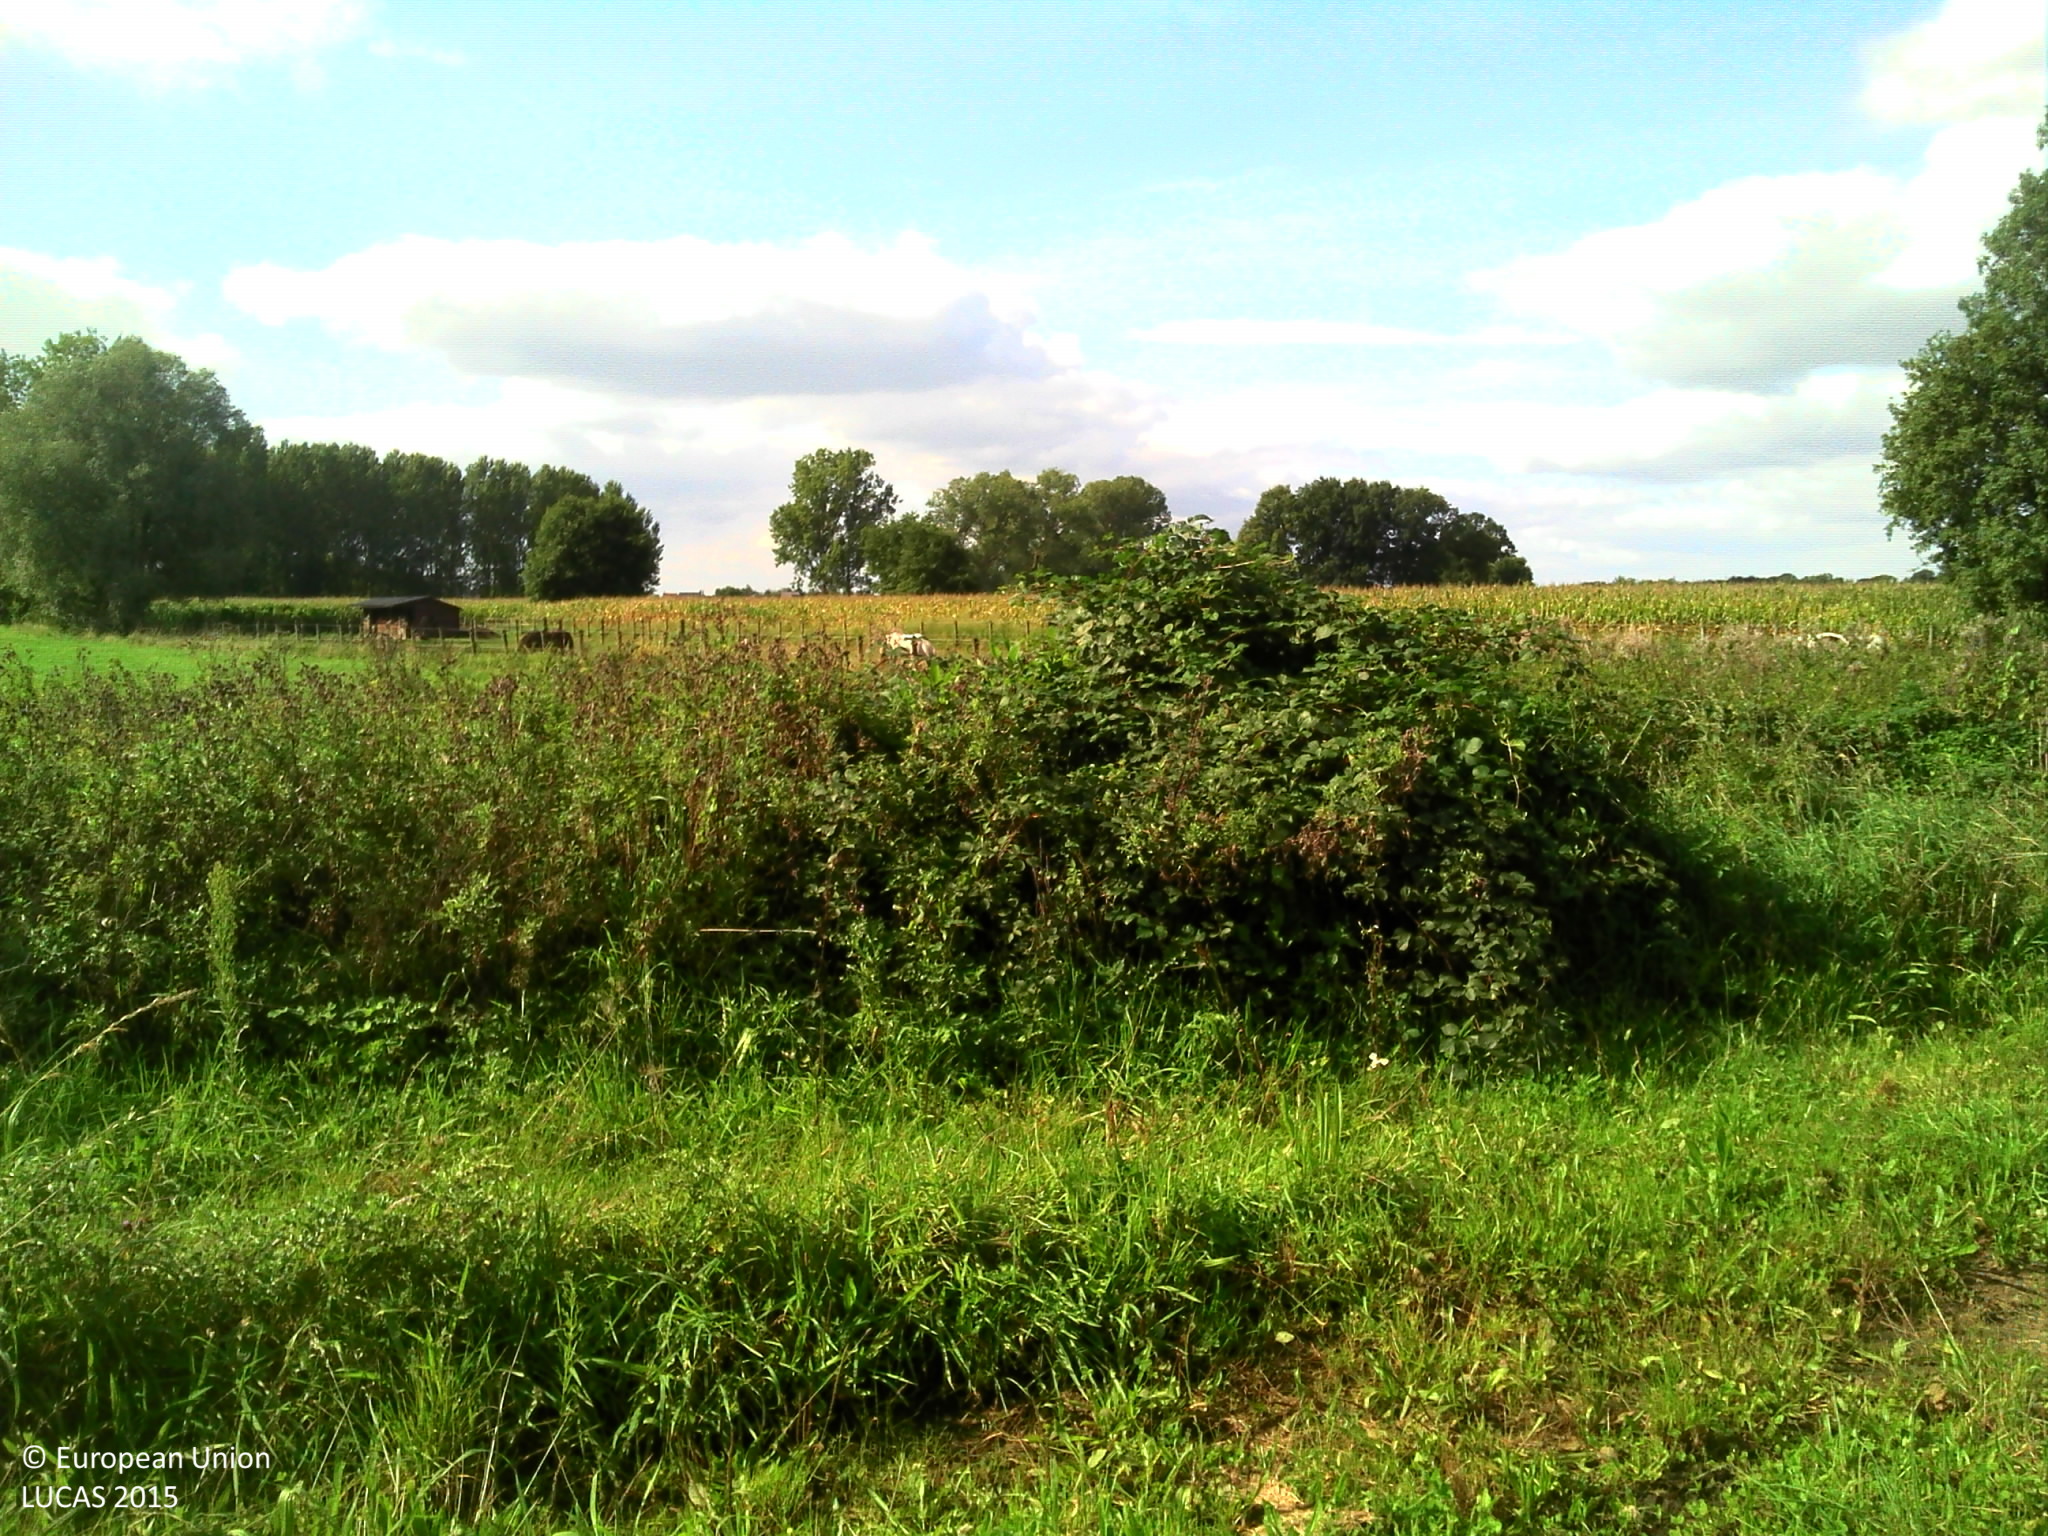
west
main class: Grassland
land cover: Grassland without tree/shrub cover
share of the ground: > 75 %
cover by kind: herbaceous plants 100 %
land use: Agriculture (excluding fallow land and kitchen gardens)
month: September
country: BE
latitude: 51.1227
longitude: 4.6670
